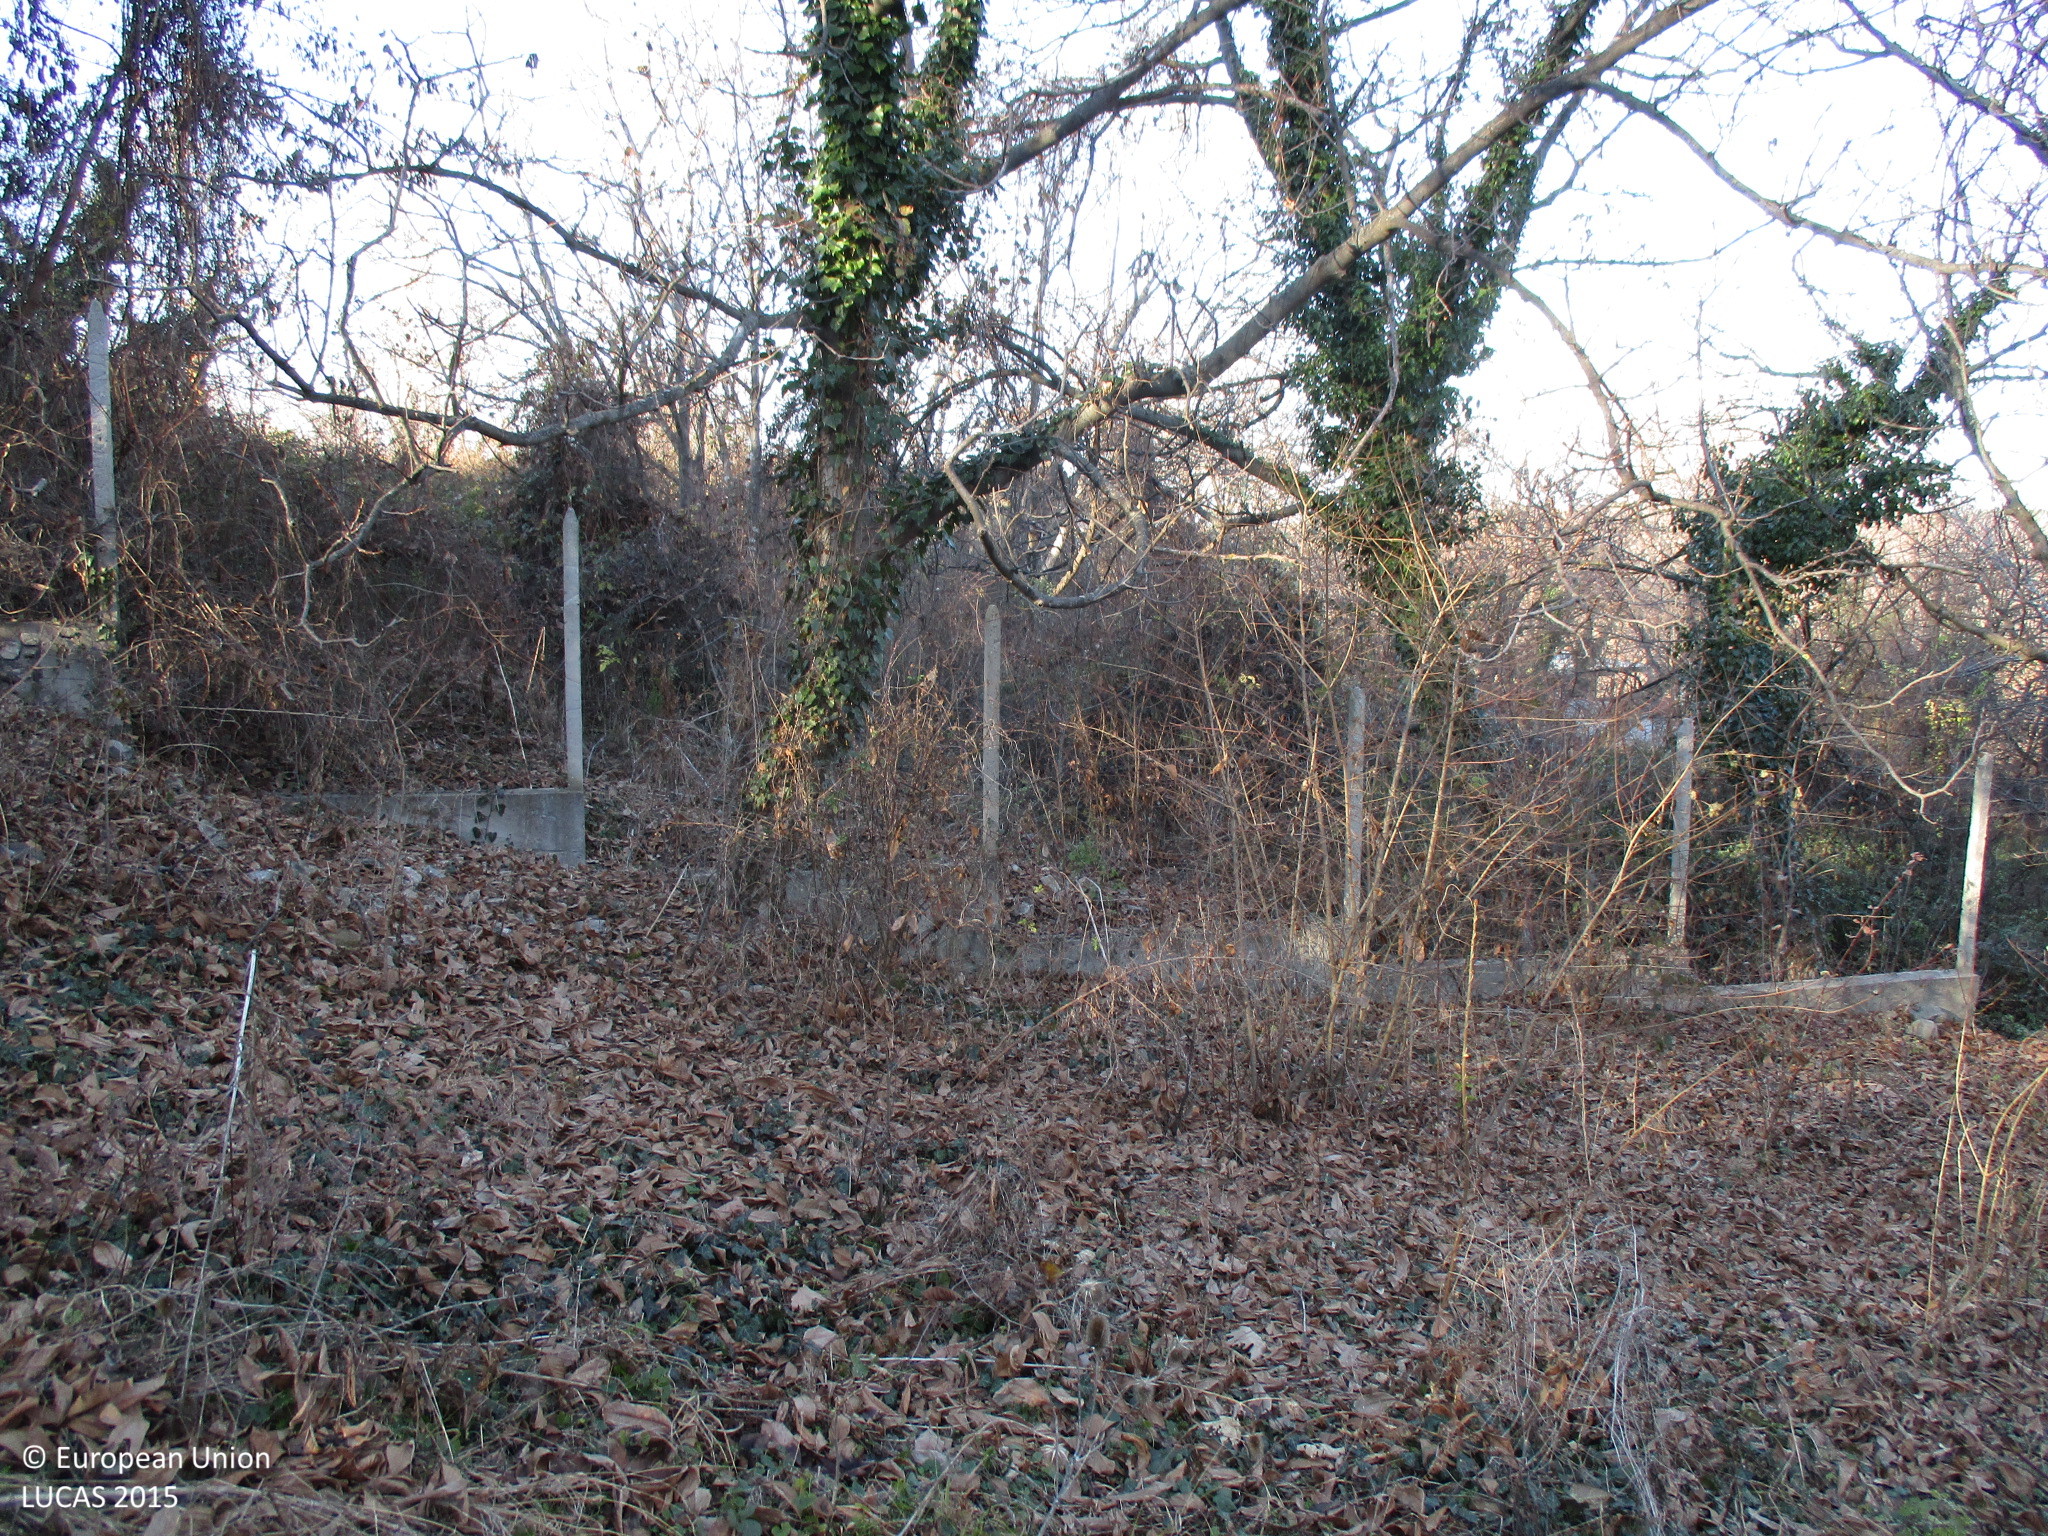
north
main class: Woodland
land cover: Broadleaved woodland
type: mesophytic deciduous forest
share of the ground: > 75 %
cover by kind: broadleaved forest trees 90 %, shrubs 10 %
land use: Semi-natural and natural areas not in use
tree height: > 5 m
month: December
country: BG
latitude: 42.0363
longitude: 24.6774
